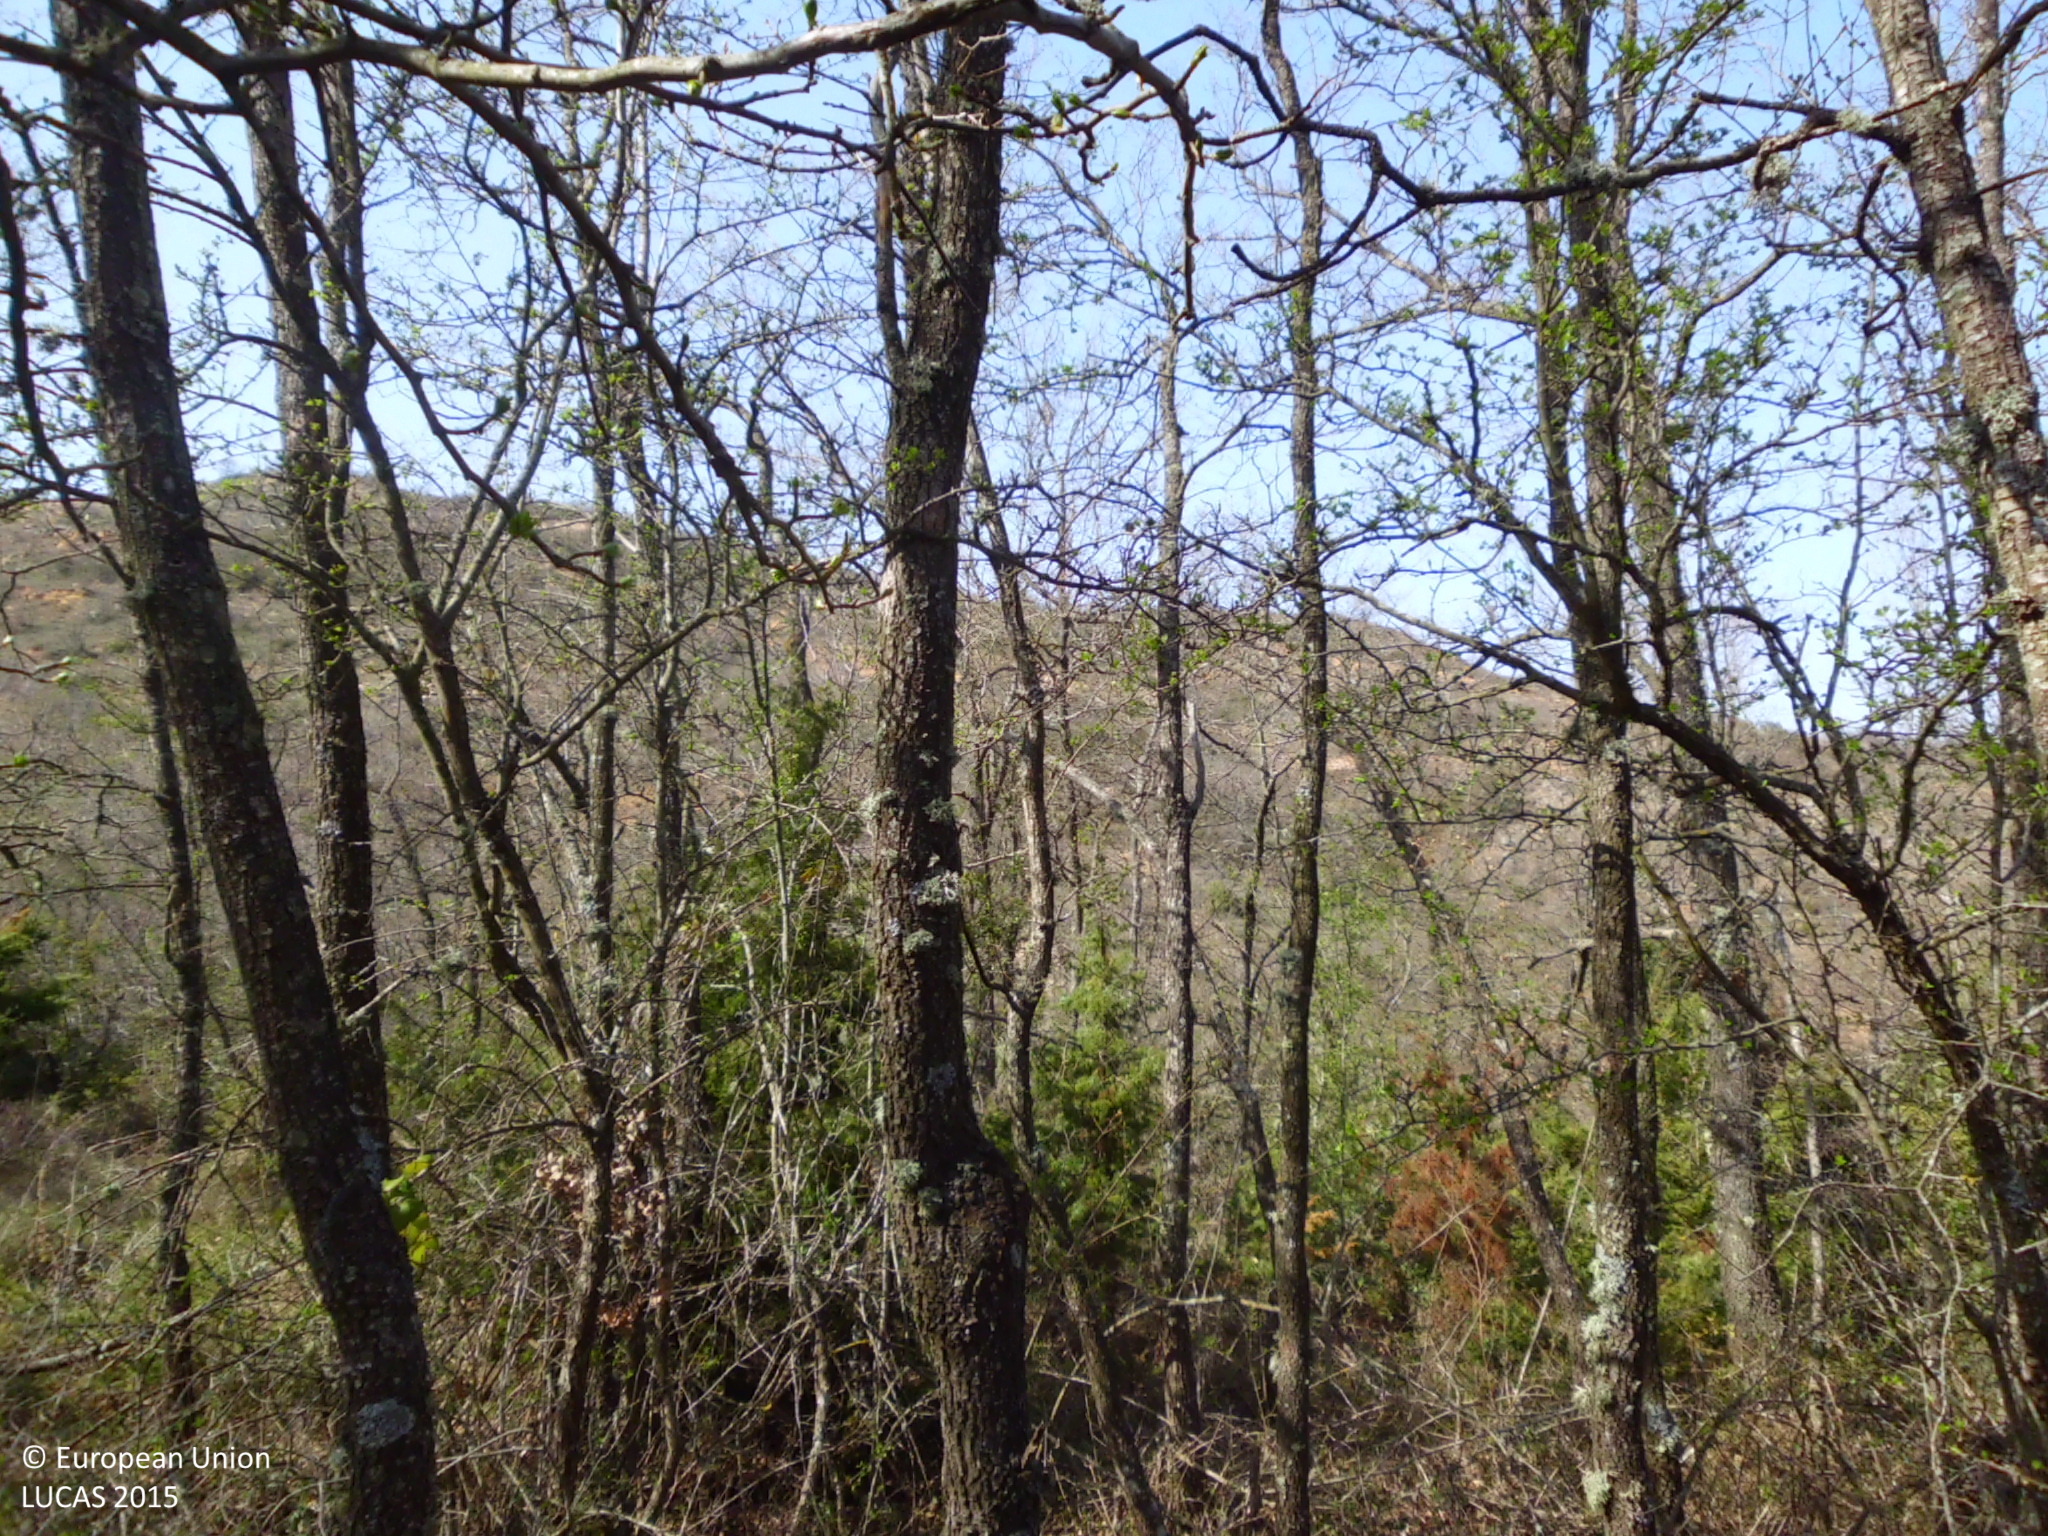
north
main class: Woodland
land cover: Broadleaved woodland
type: acidophilous oak and oak-birch forest
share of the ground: > 75 %
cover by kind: broadleaved forest trees 90 %, shrubs 10 %
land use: Semi-natural and natural areas not in use
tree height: > 5 m
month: April
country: ES
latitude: 42.5816
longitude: -3.4005
